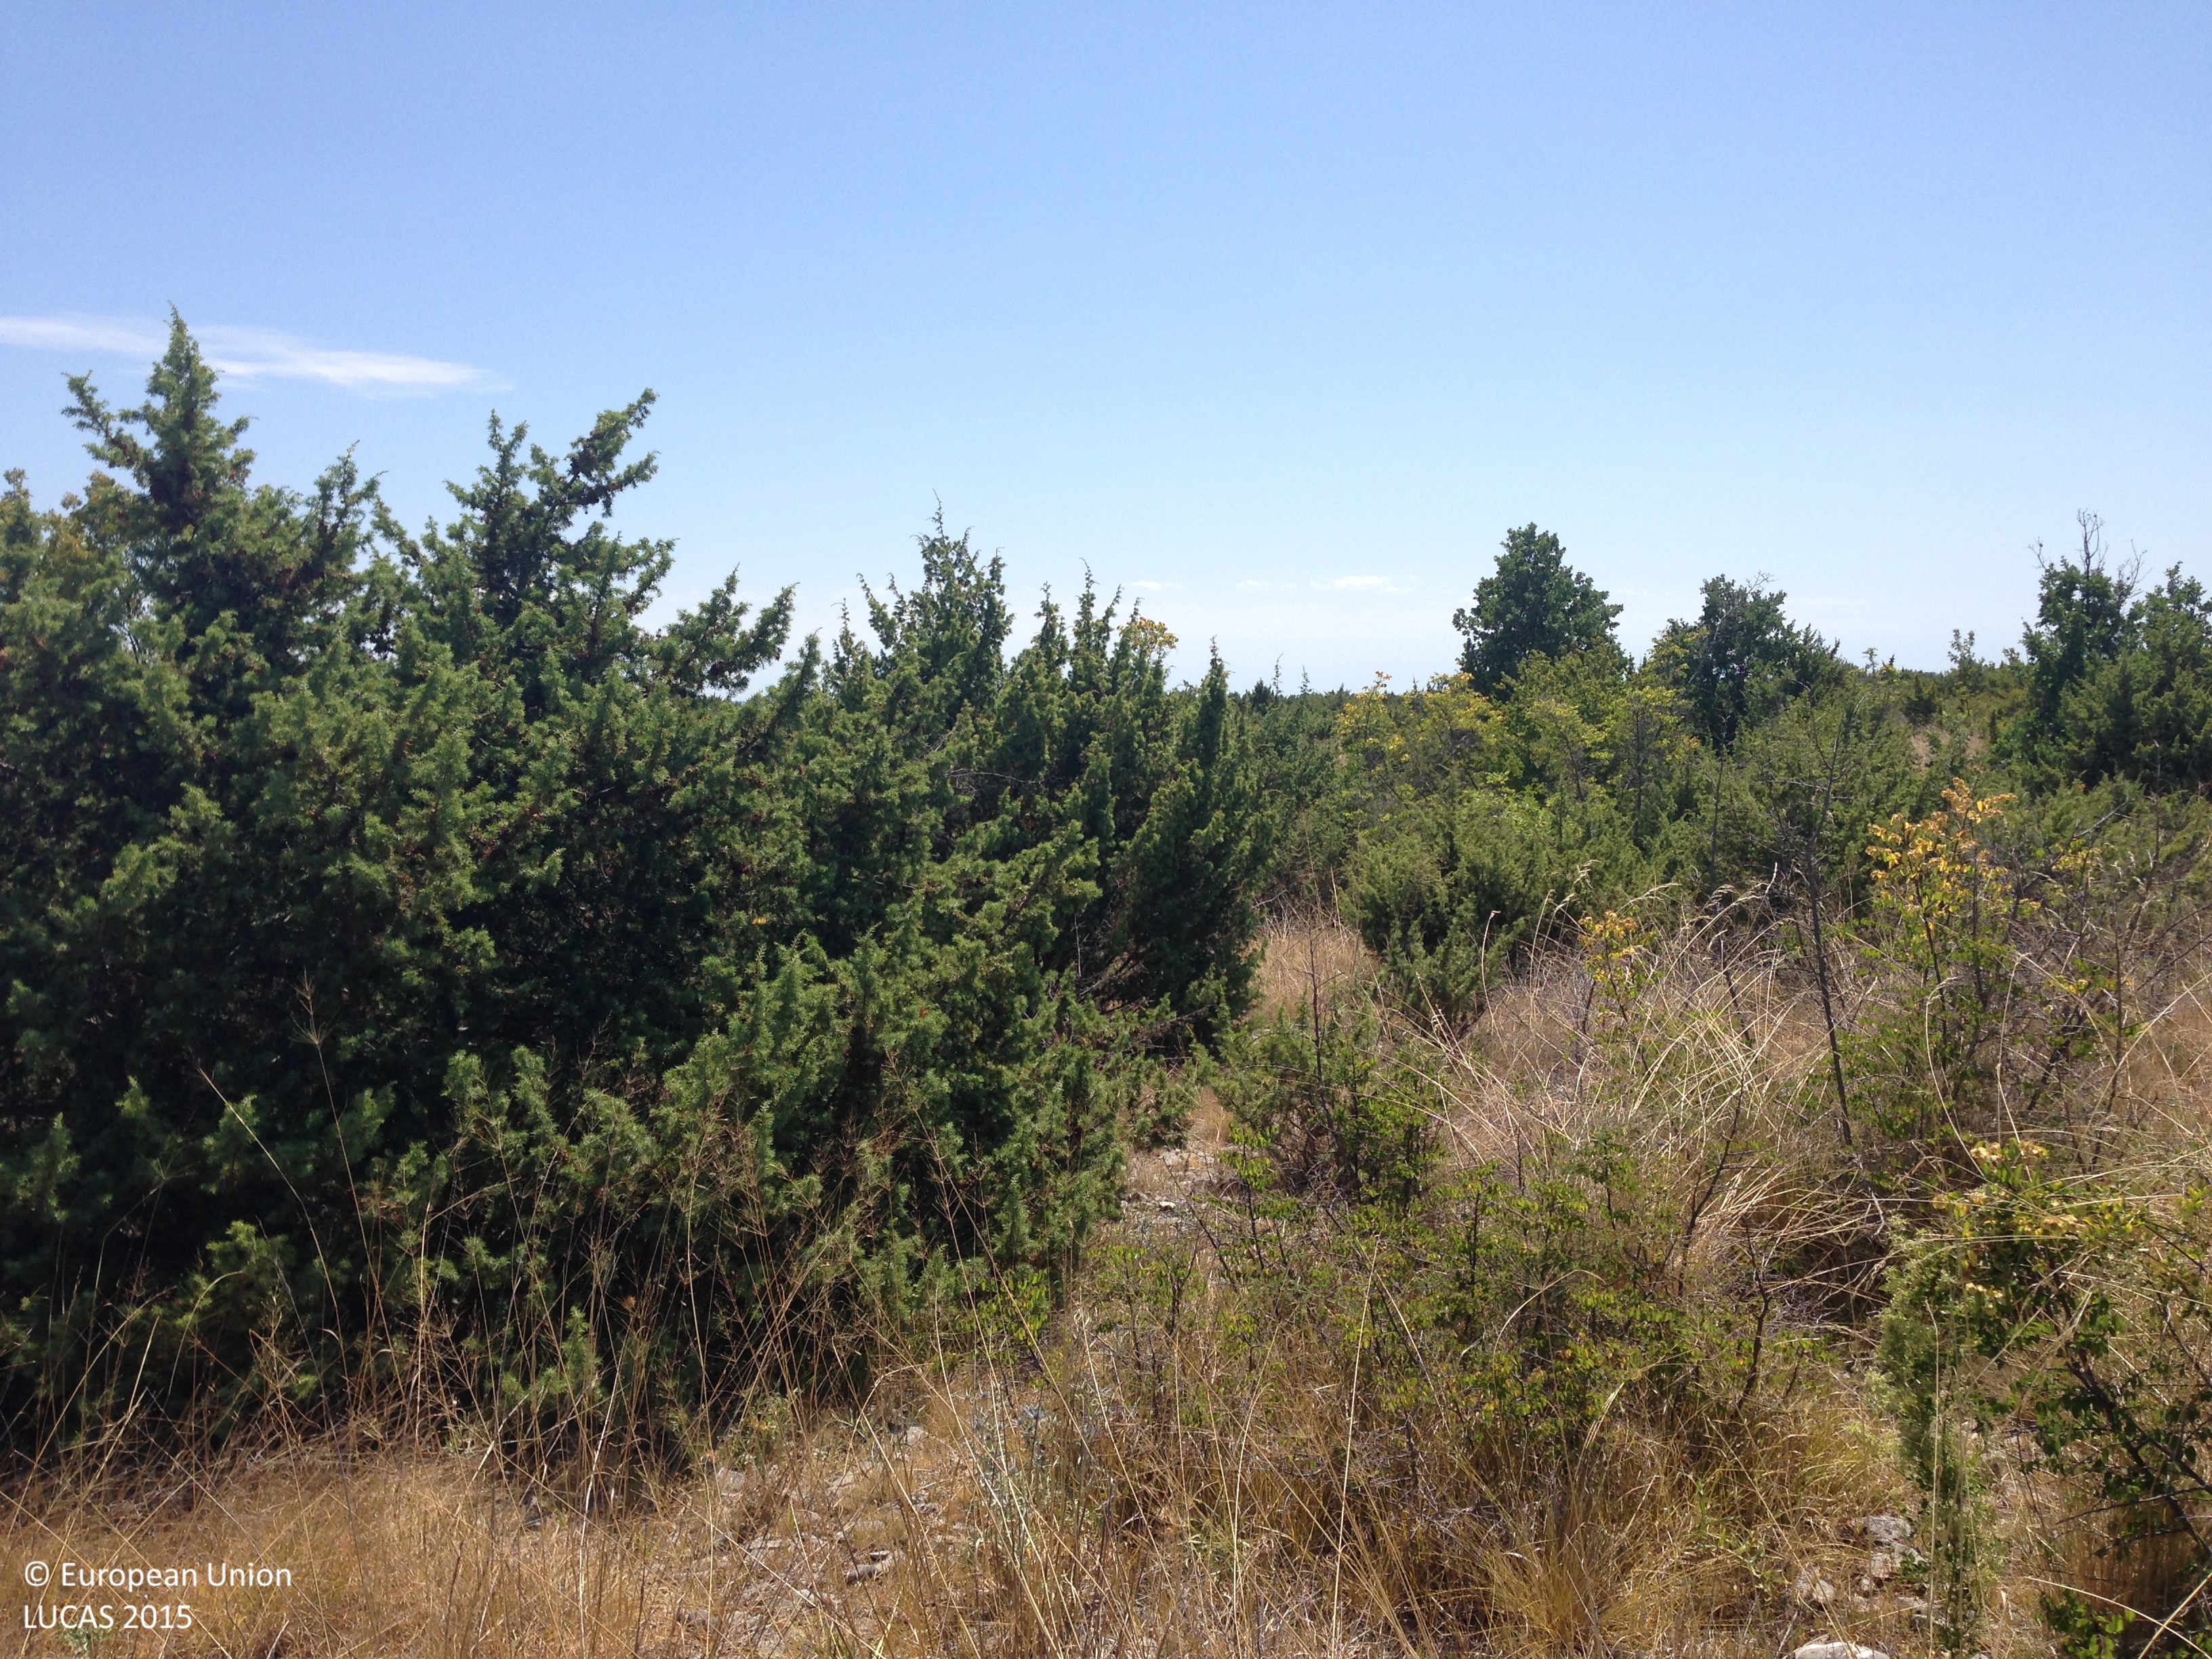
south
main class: Shrubland
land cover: Shrubland with sparse tree cover
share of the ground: > 75 %
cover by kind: shrubs 35 %, herbaceous plants 35 %, consolidated bare surface 15 %, unconsolidated bare surface 10 %, broadleaved forest trees 5 %
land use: Semi-natural and natural areas not in use
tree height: < 5 m
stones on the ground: < 10 %
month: July
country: HR
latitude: 44.0175
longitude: 15.9425
